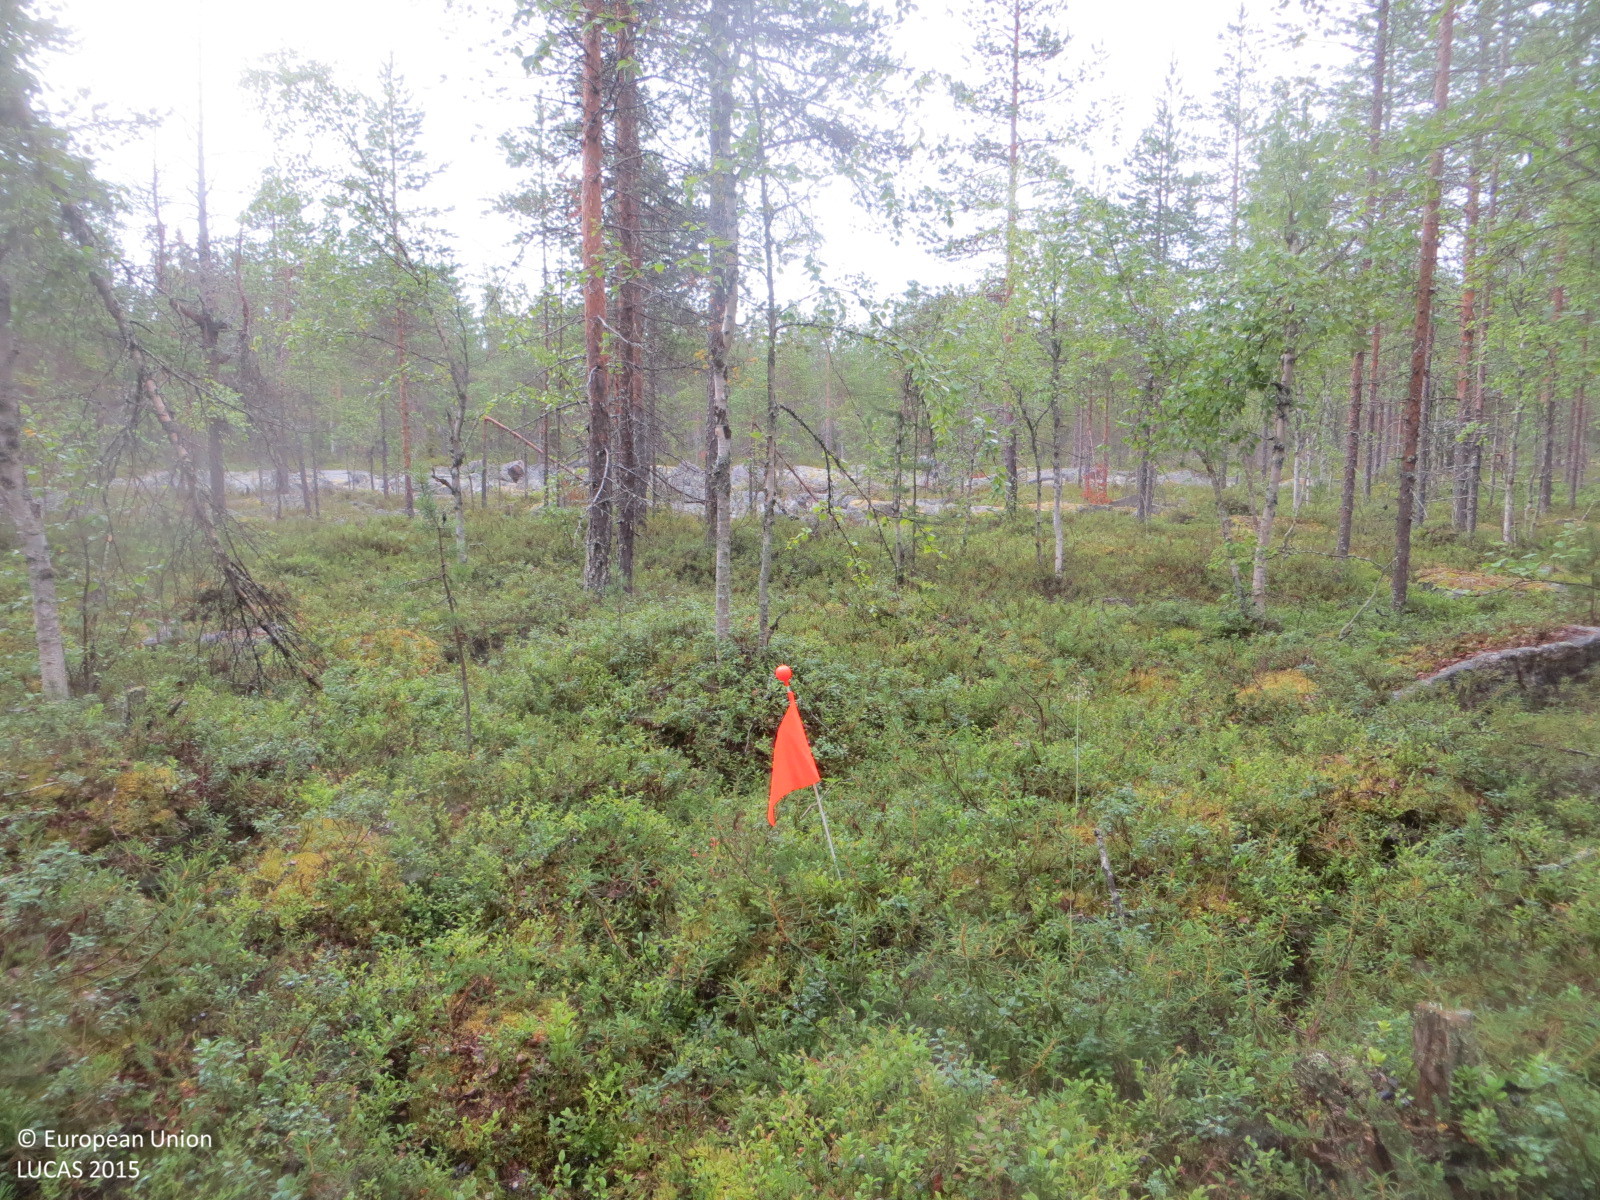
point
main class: Woodland
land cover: Pine dominated mixed woodland
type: boreal forest
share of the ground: 50 - 75 %
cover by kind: shrubs 50 %, coniferous forest trees 25 %, broadleaved forest trees 25 %
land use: Forestry
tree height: > 5 m
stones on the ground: 25 - 50 %
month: August
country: FI
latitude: 65.9331
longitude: 25.2069
